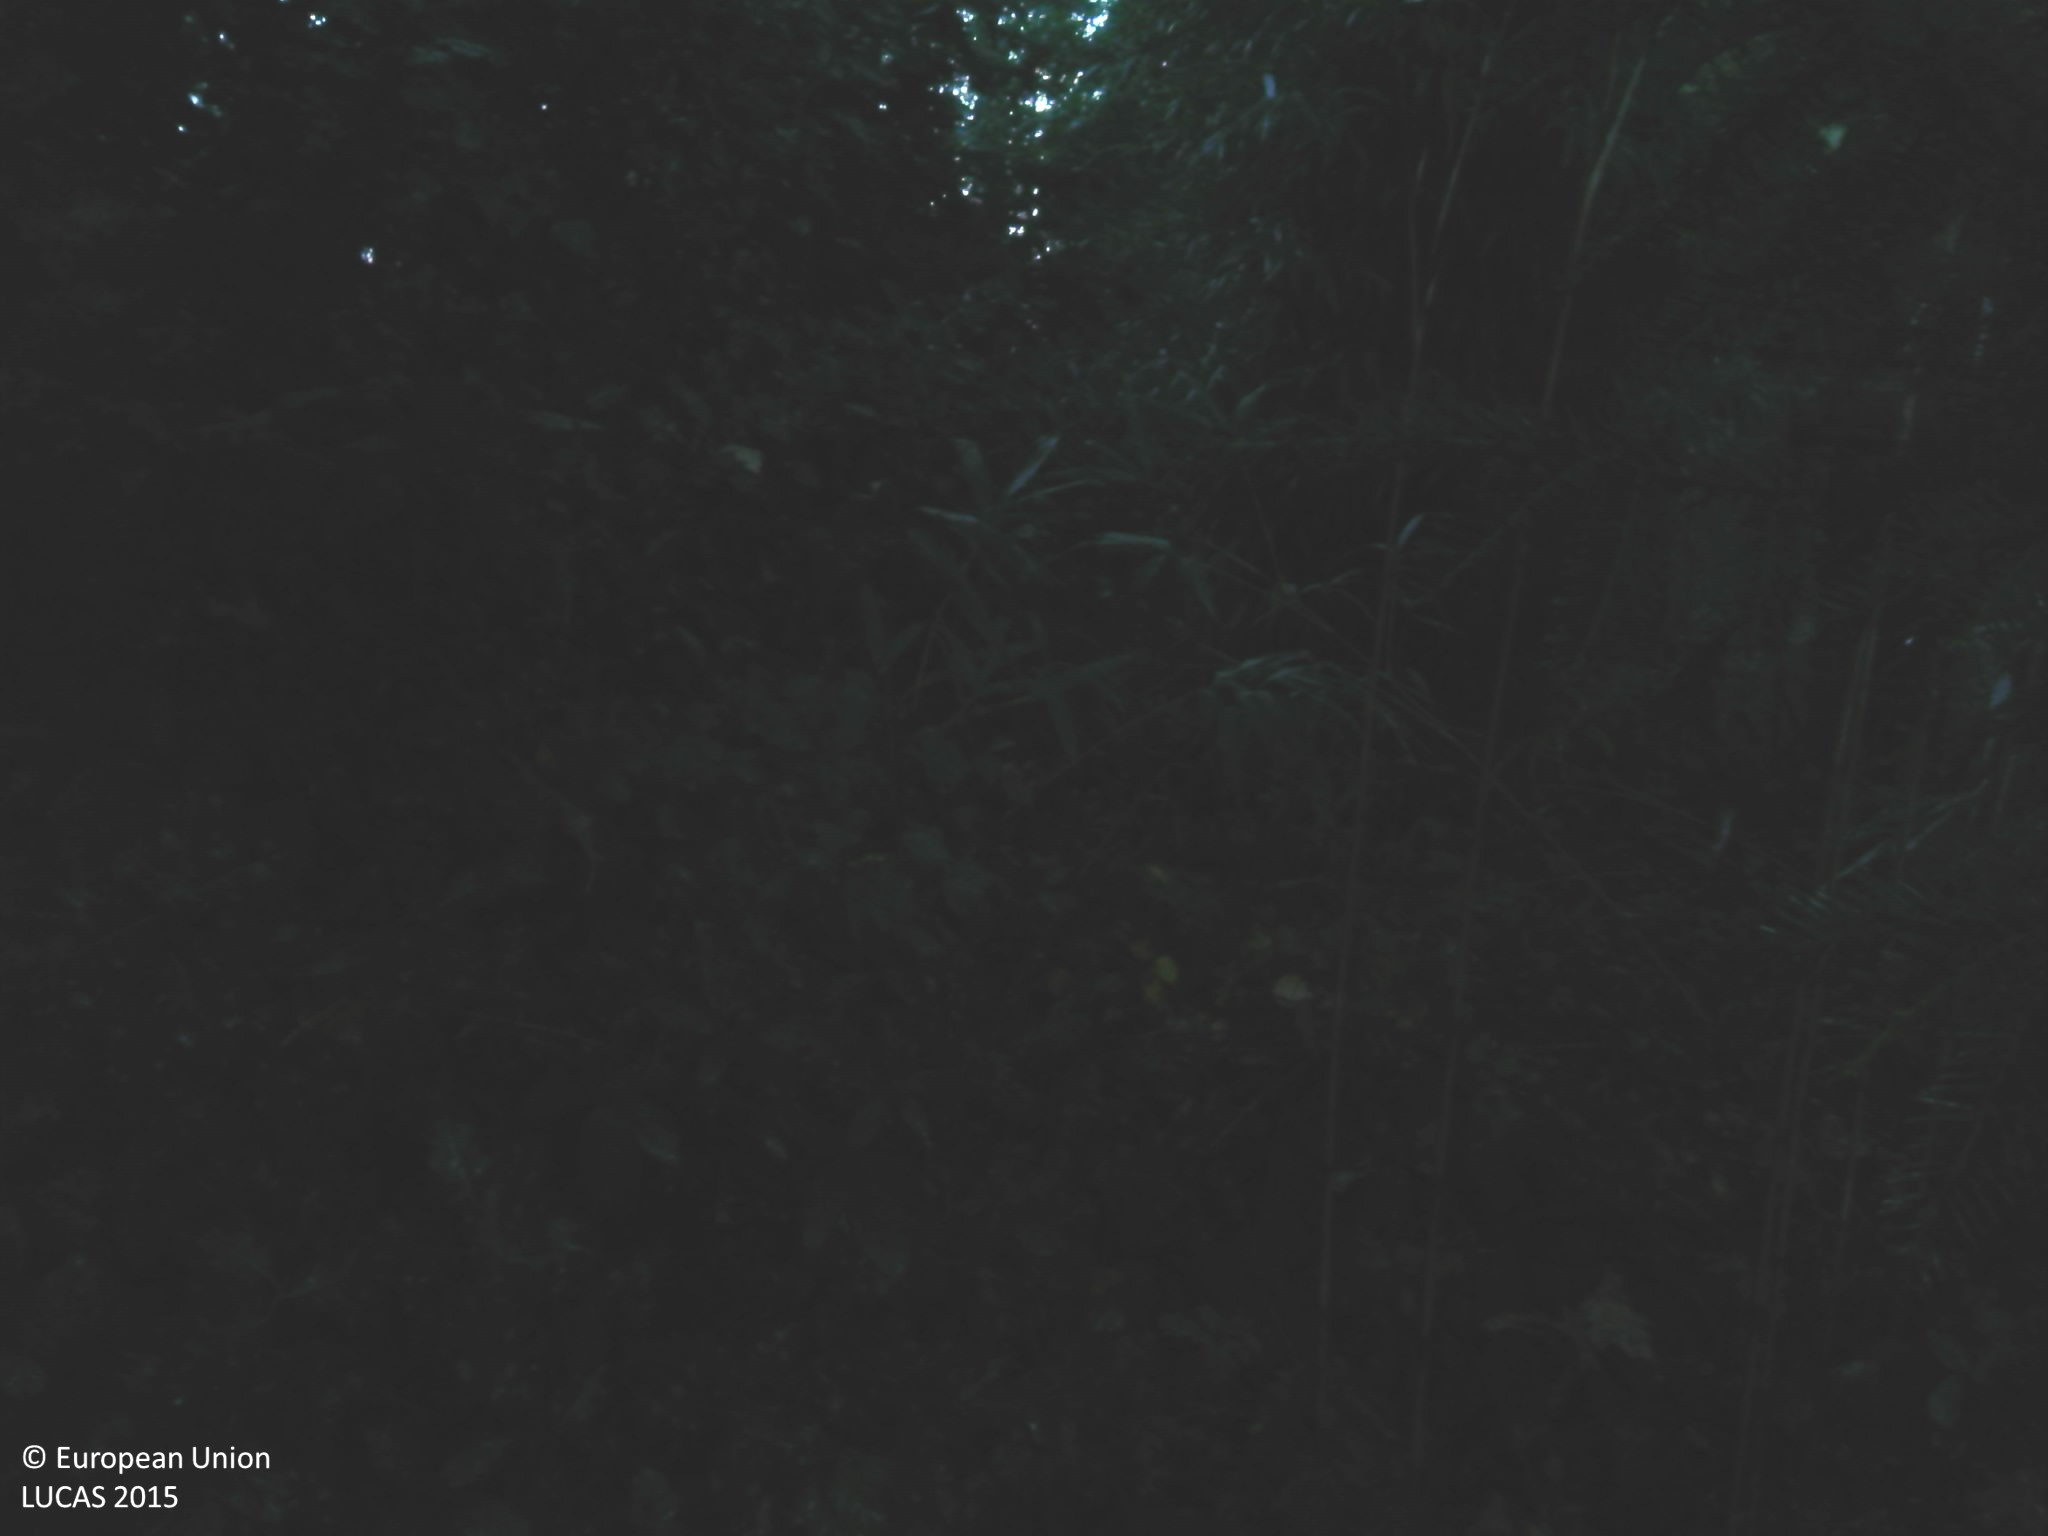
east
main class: Grassland
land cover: Grassland without tree/shrub cover
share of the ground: > 75 %
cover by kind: herbaceous plants 100 %
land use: Residential
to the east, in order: Grassland without tree/shrub cover; Fences; Broadleaved woodland; Inland fresh water bodies; Broadleaved woodland; Inland fresh water bodies; Broadleaved woodland; Grassland without tree/shrub cover; Artificial constructions in urban areas
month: October
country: BE
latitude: 51.3269
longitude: 4.4129
